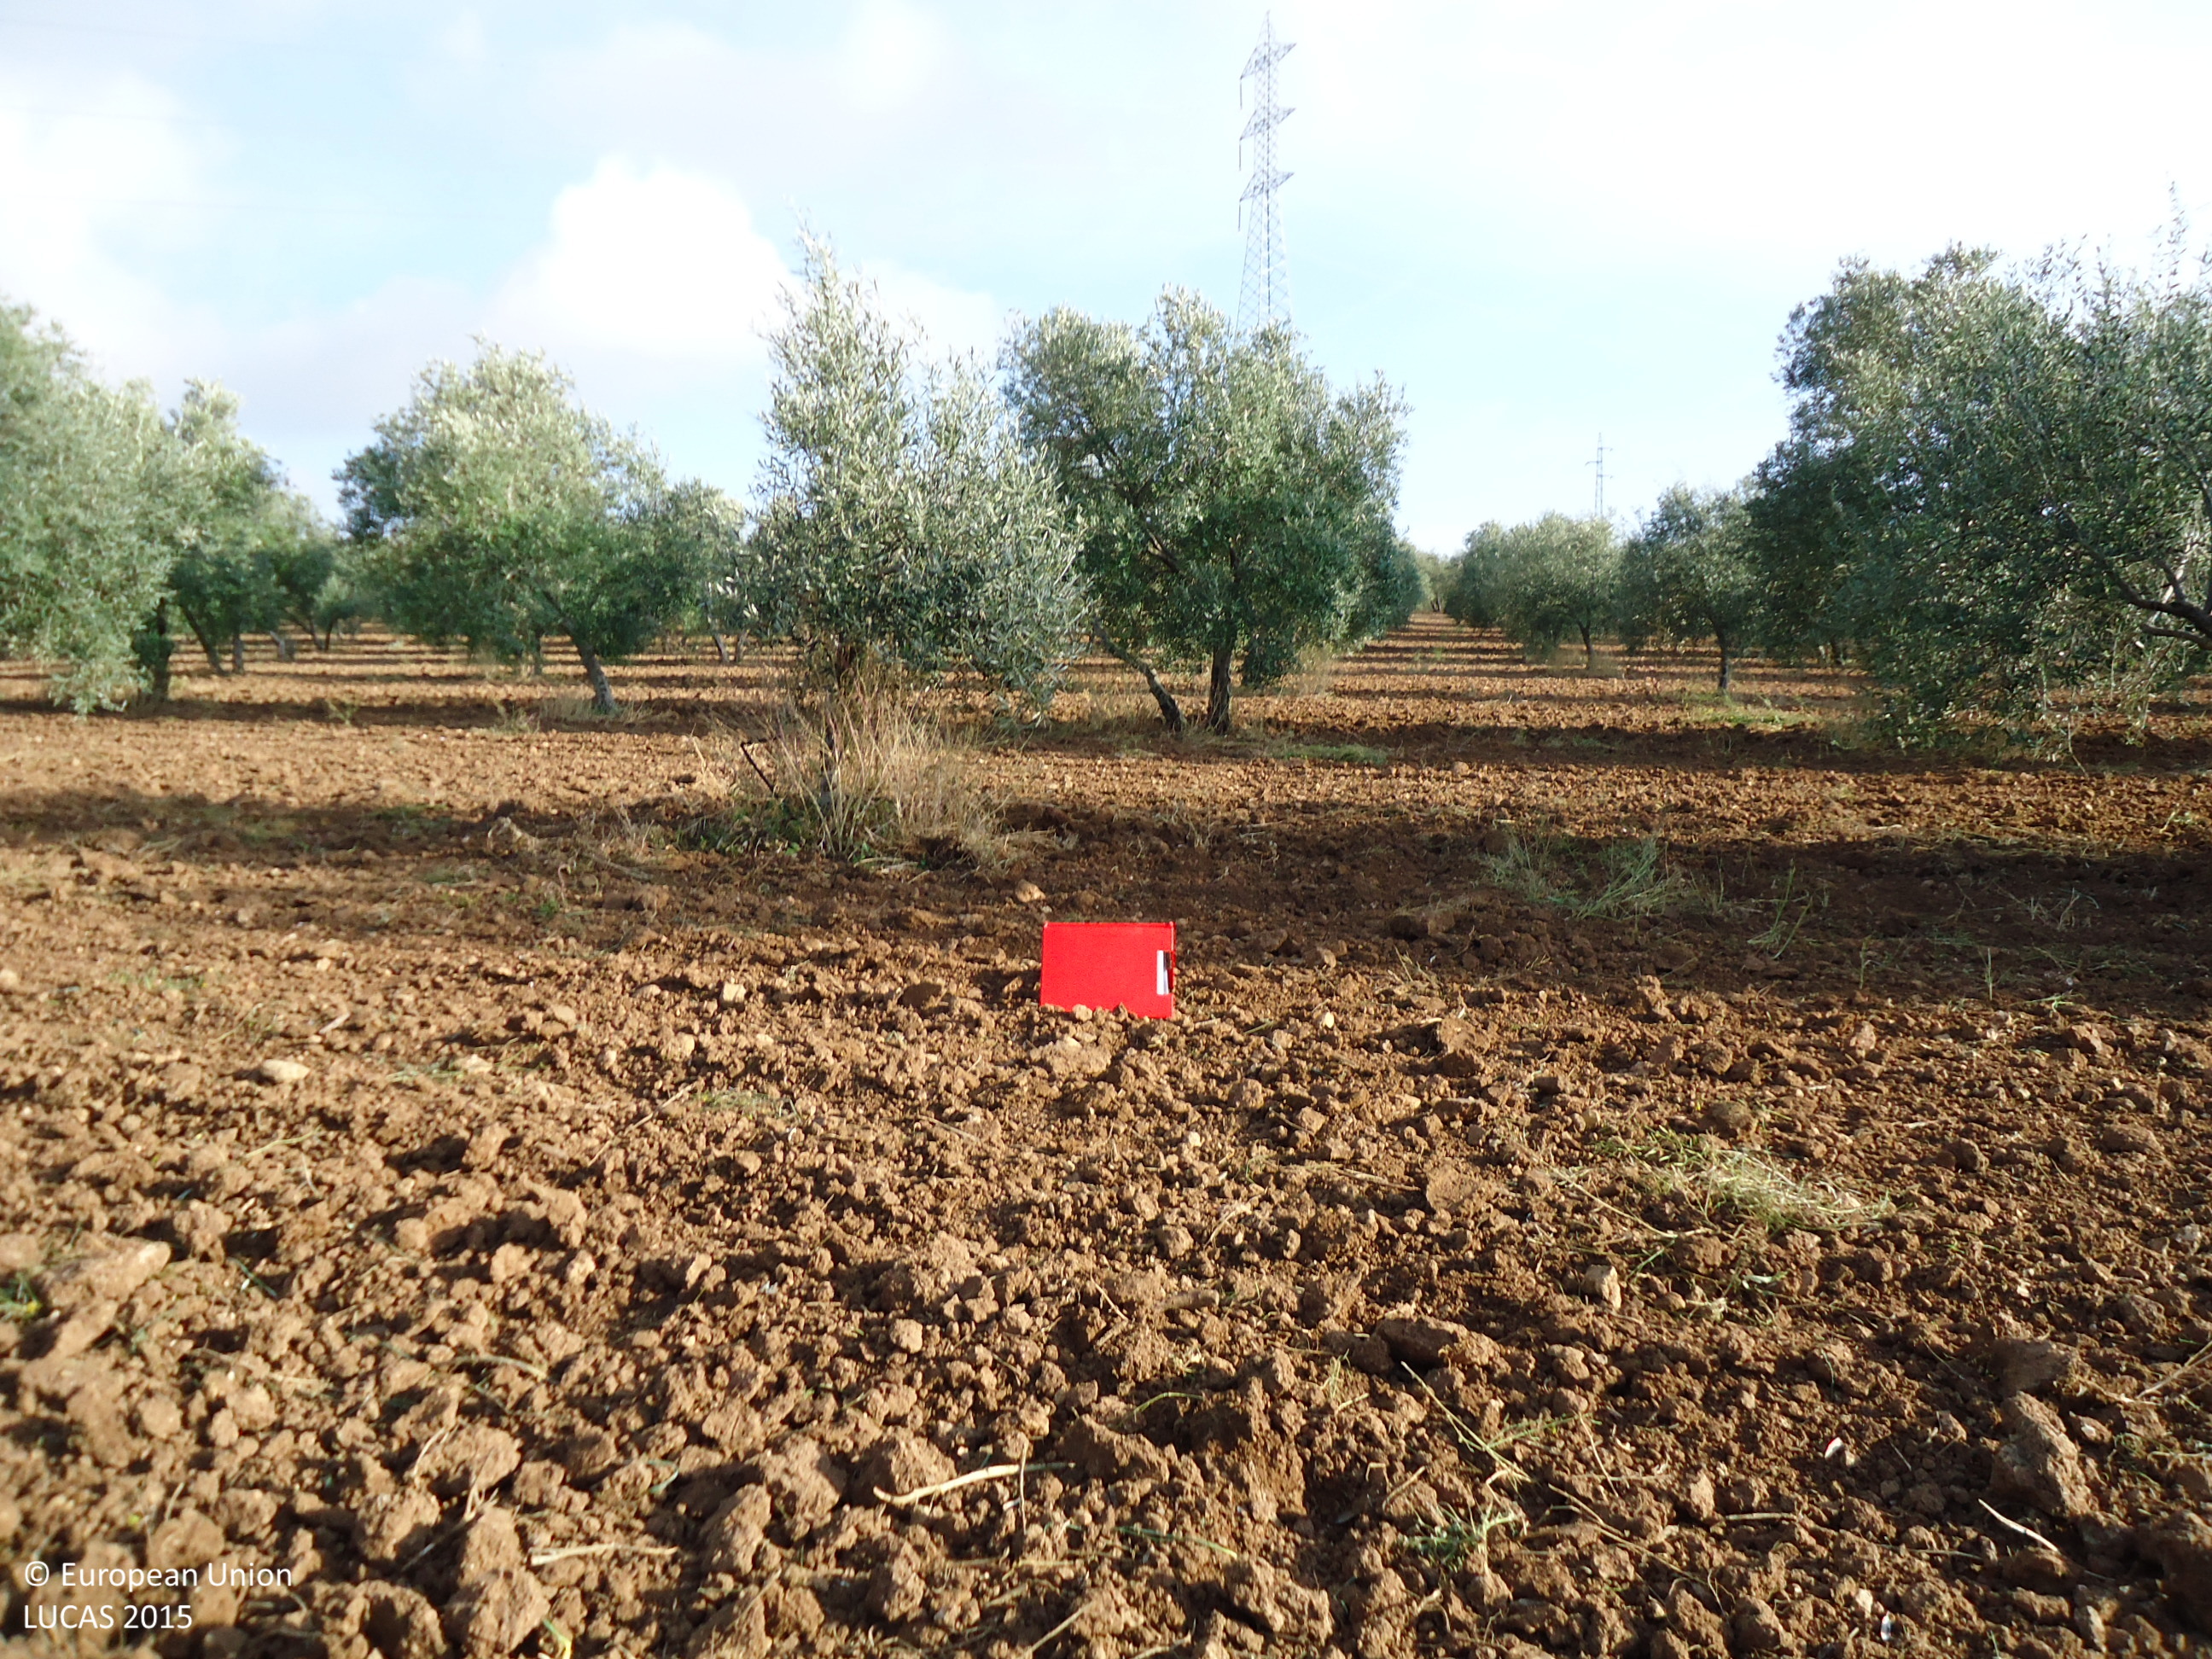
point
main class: Cropland
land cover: Olive groves
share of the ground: 25 - 50 %
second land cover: Other bare soil
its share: > 75 %
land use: Agriculture (excluding fallow land and kitchen gardens)
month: April
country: ES
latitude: 37.2015
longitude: -4.8418
